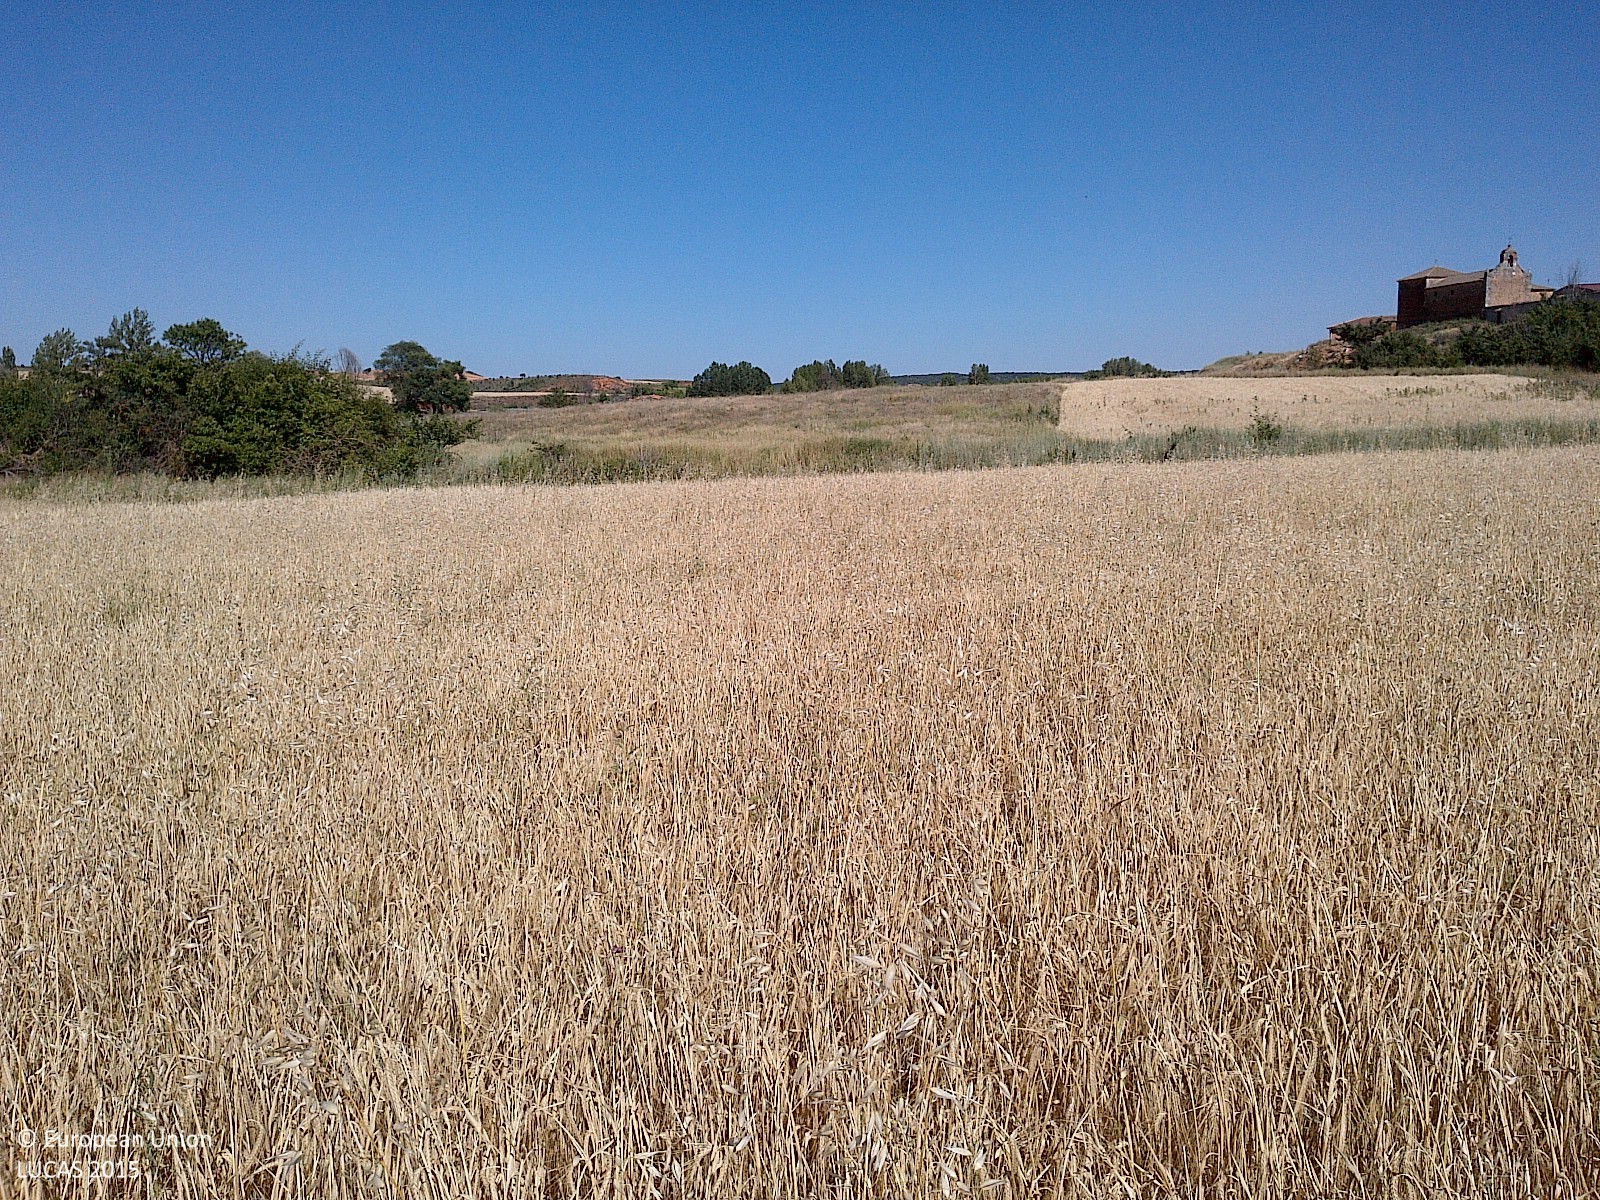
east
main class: Cropland
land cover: Barley
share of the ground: > 75 %
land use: Agriculture (excluding fallow land and kitchen gardens)
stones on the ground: < 10 %
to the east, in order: Barley; Shruby margins; Spontaneously vegetated surfaces; Barley; Oats
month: July
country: ES
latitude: 41.6377
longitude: -3.2152
